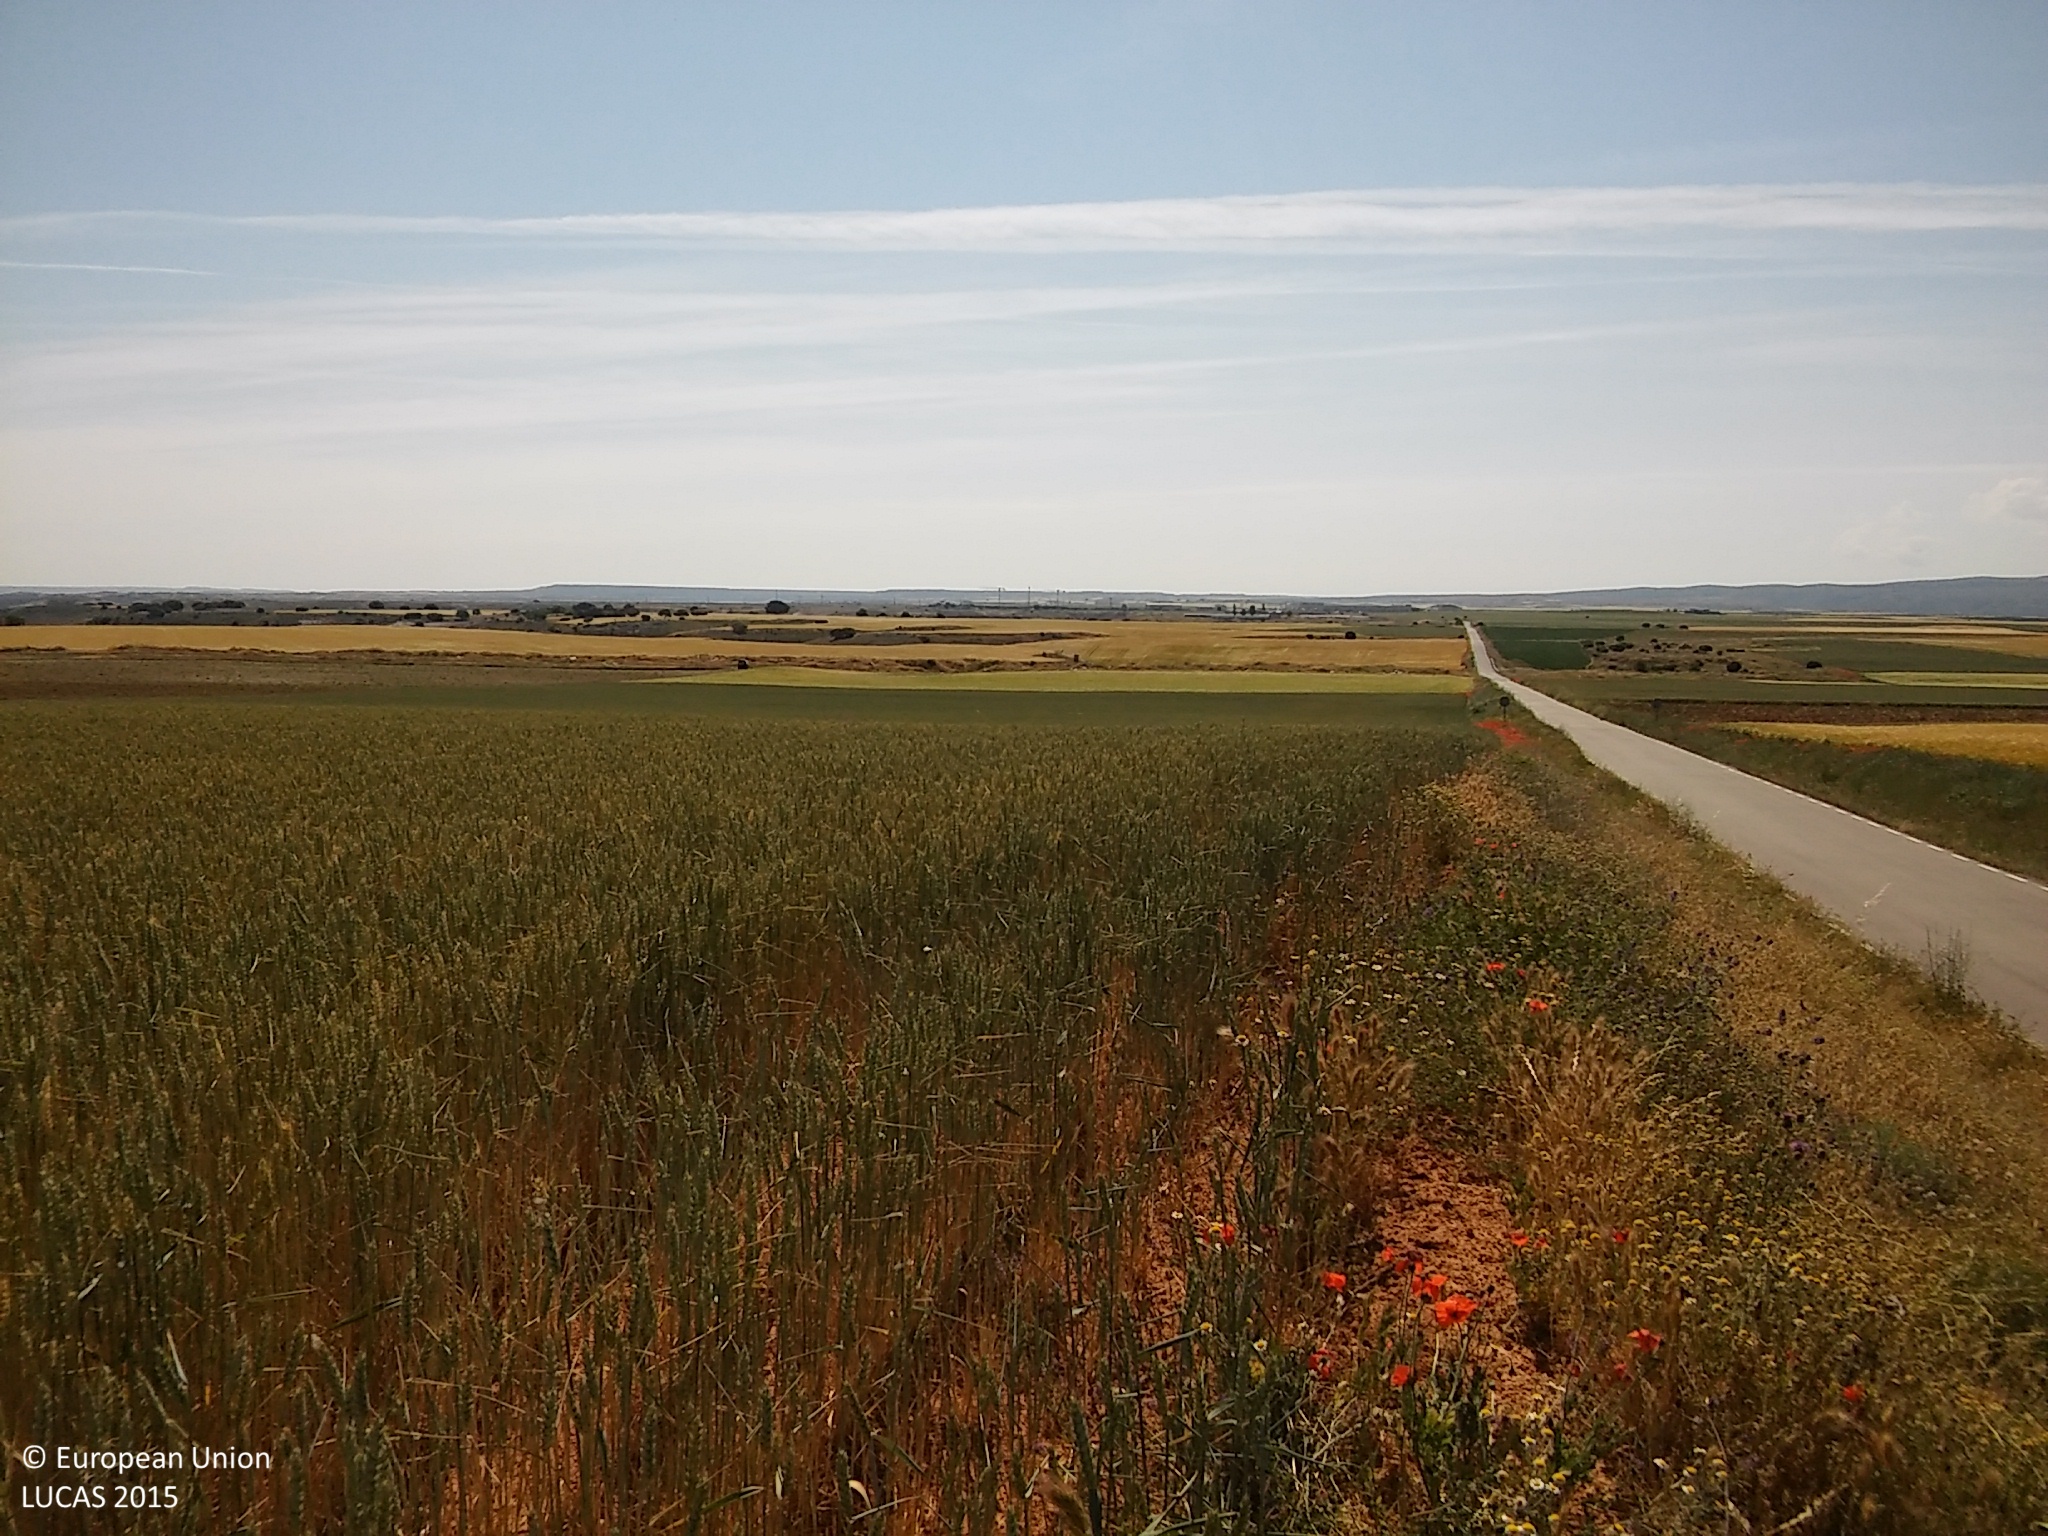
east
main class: Cropland
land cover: Common wheat
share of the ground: 50 - 75 %
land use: Agriculture (excluding fallow land and kitchen gardens)
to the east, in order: Grass margins; Common wheat
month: June
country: ES
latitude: 41.6057
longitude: -3.7193
